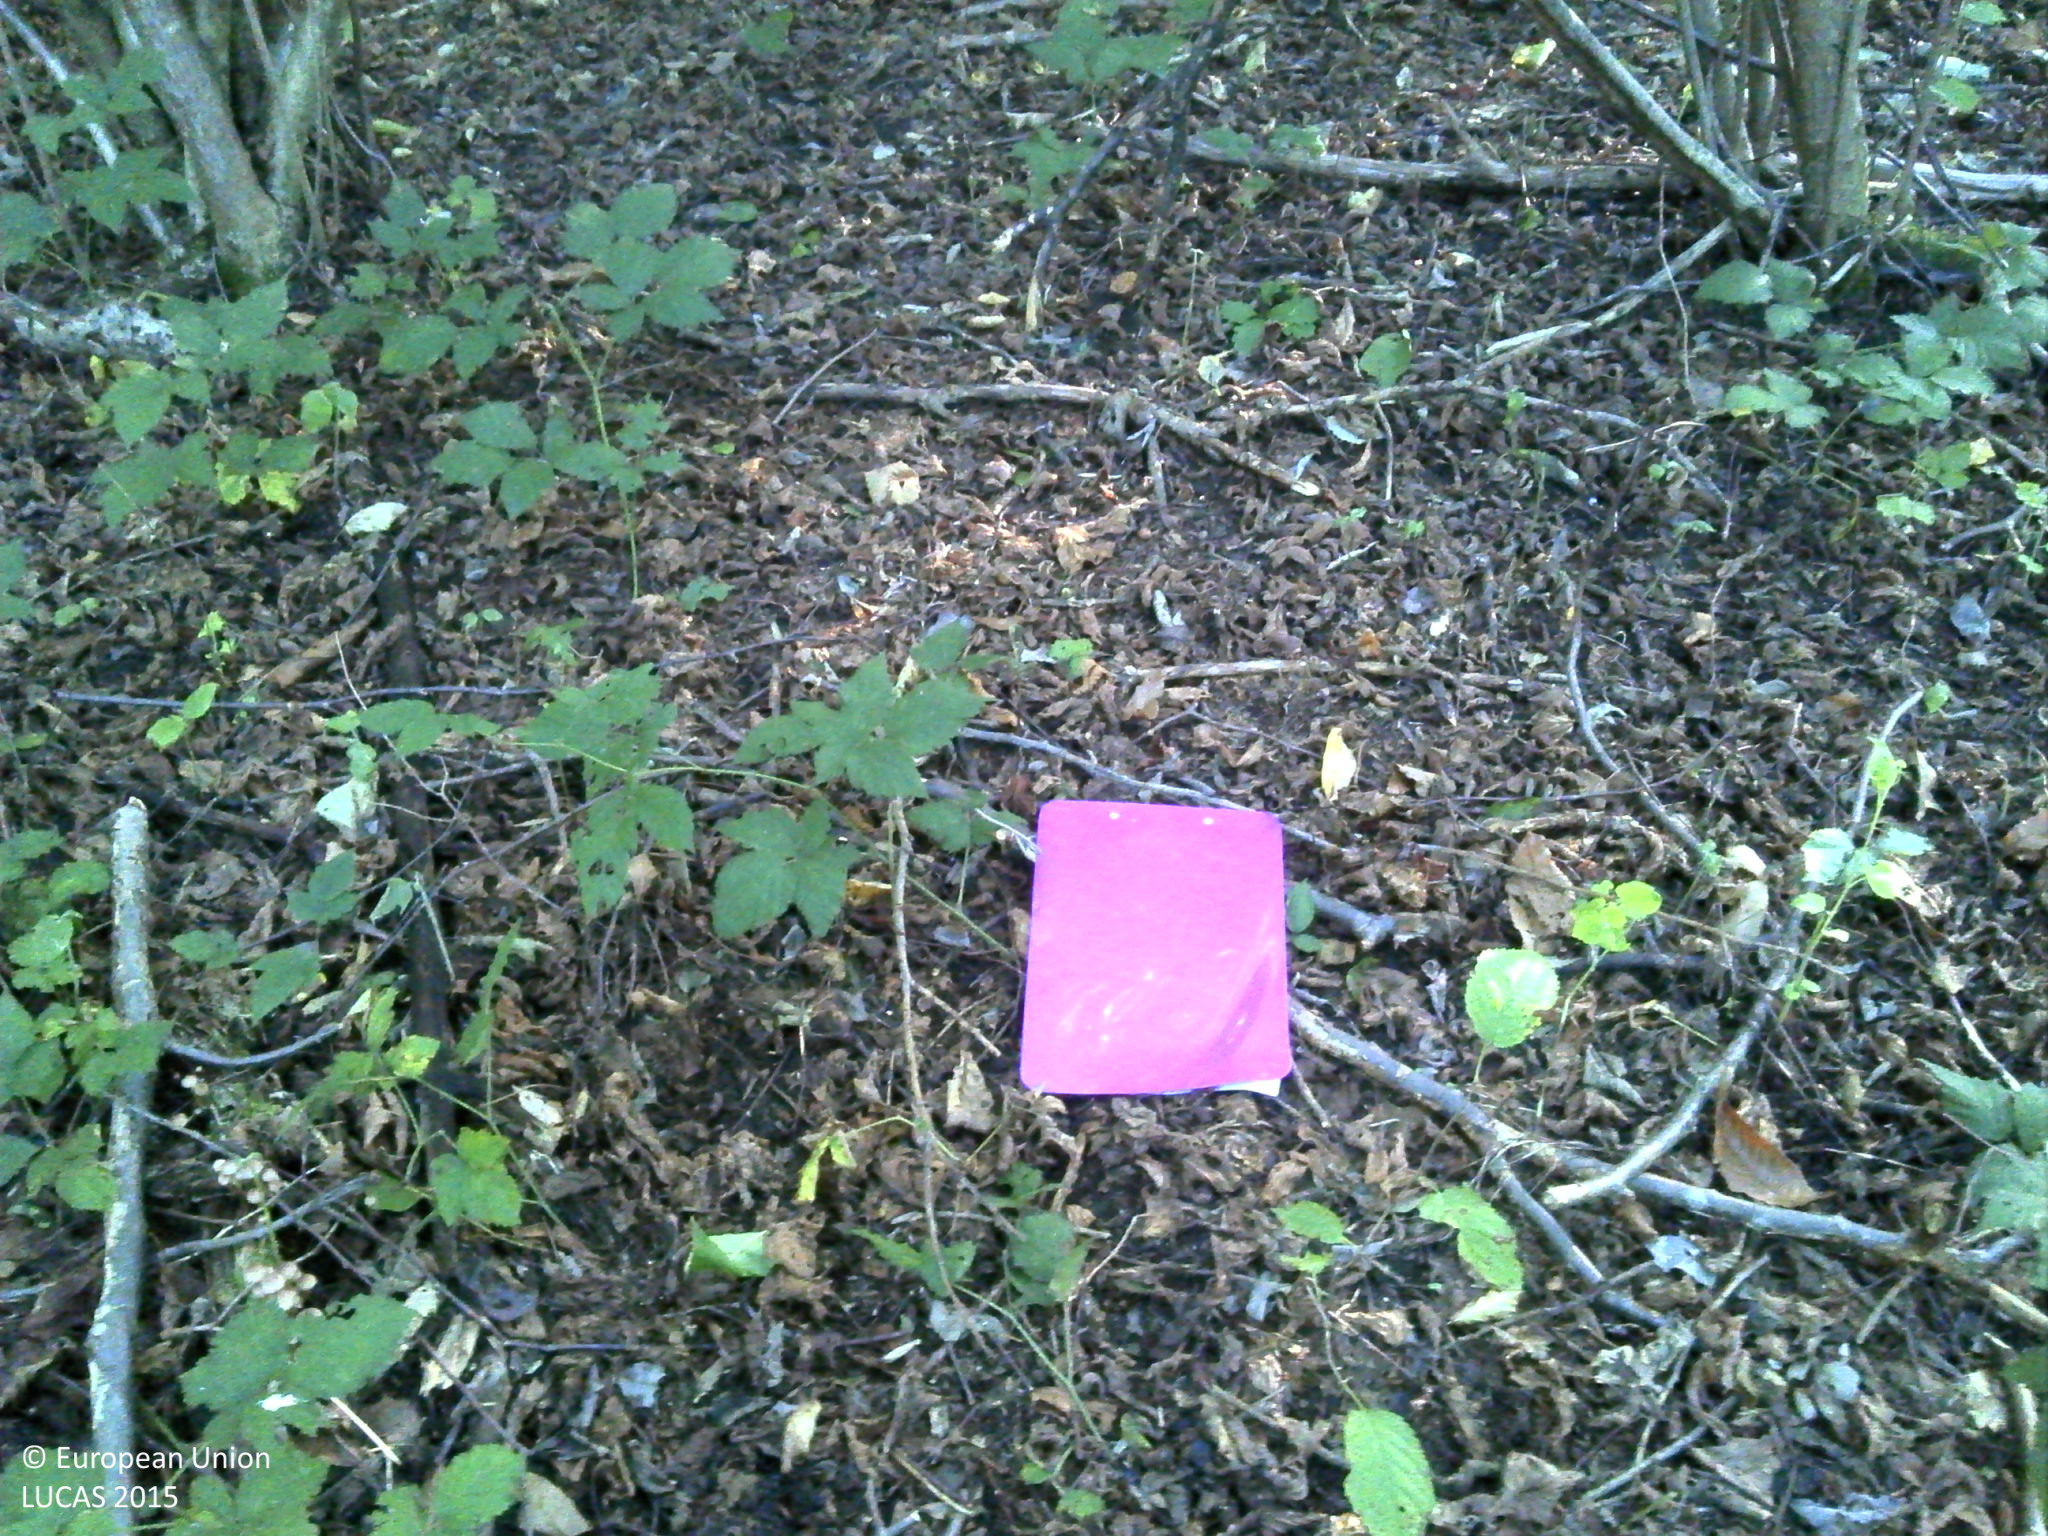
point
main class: Woodland
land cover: Broadleaved woodland
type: acidophilous oak and oak-birch forest
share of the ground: > 75 %
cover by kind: broadleaved forest trees 100 %
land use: Forestry
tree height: > 5 m
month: August
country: HR
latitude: 45.3140
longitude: 16.3368
